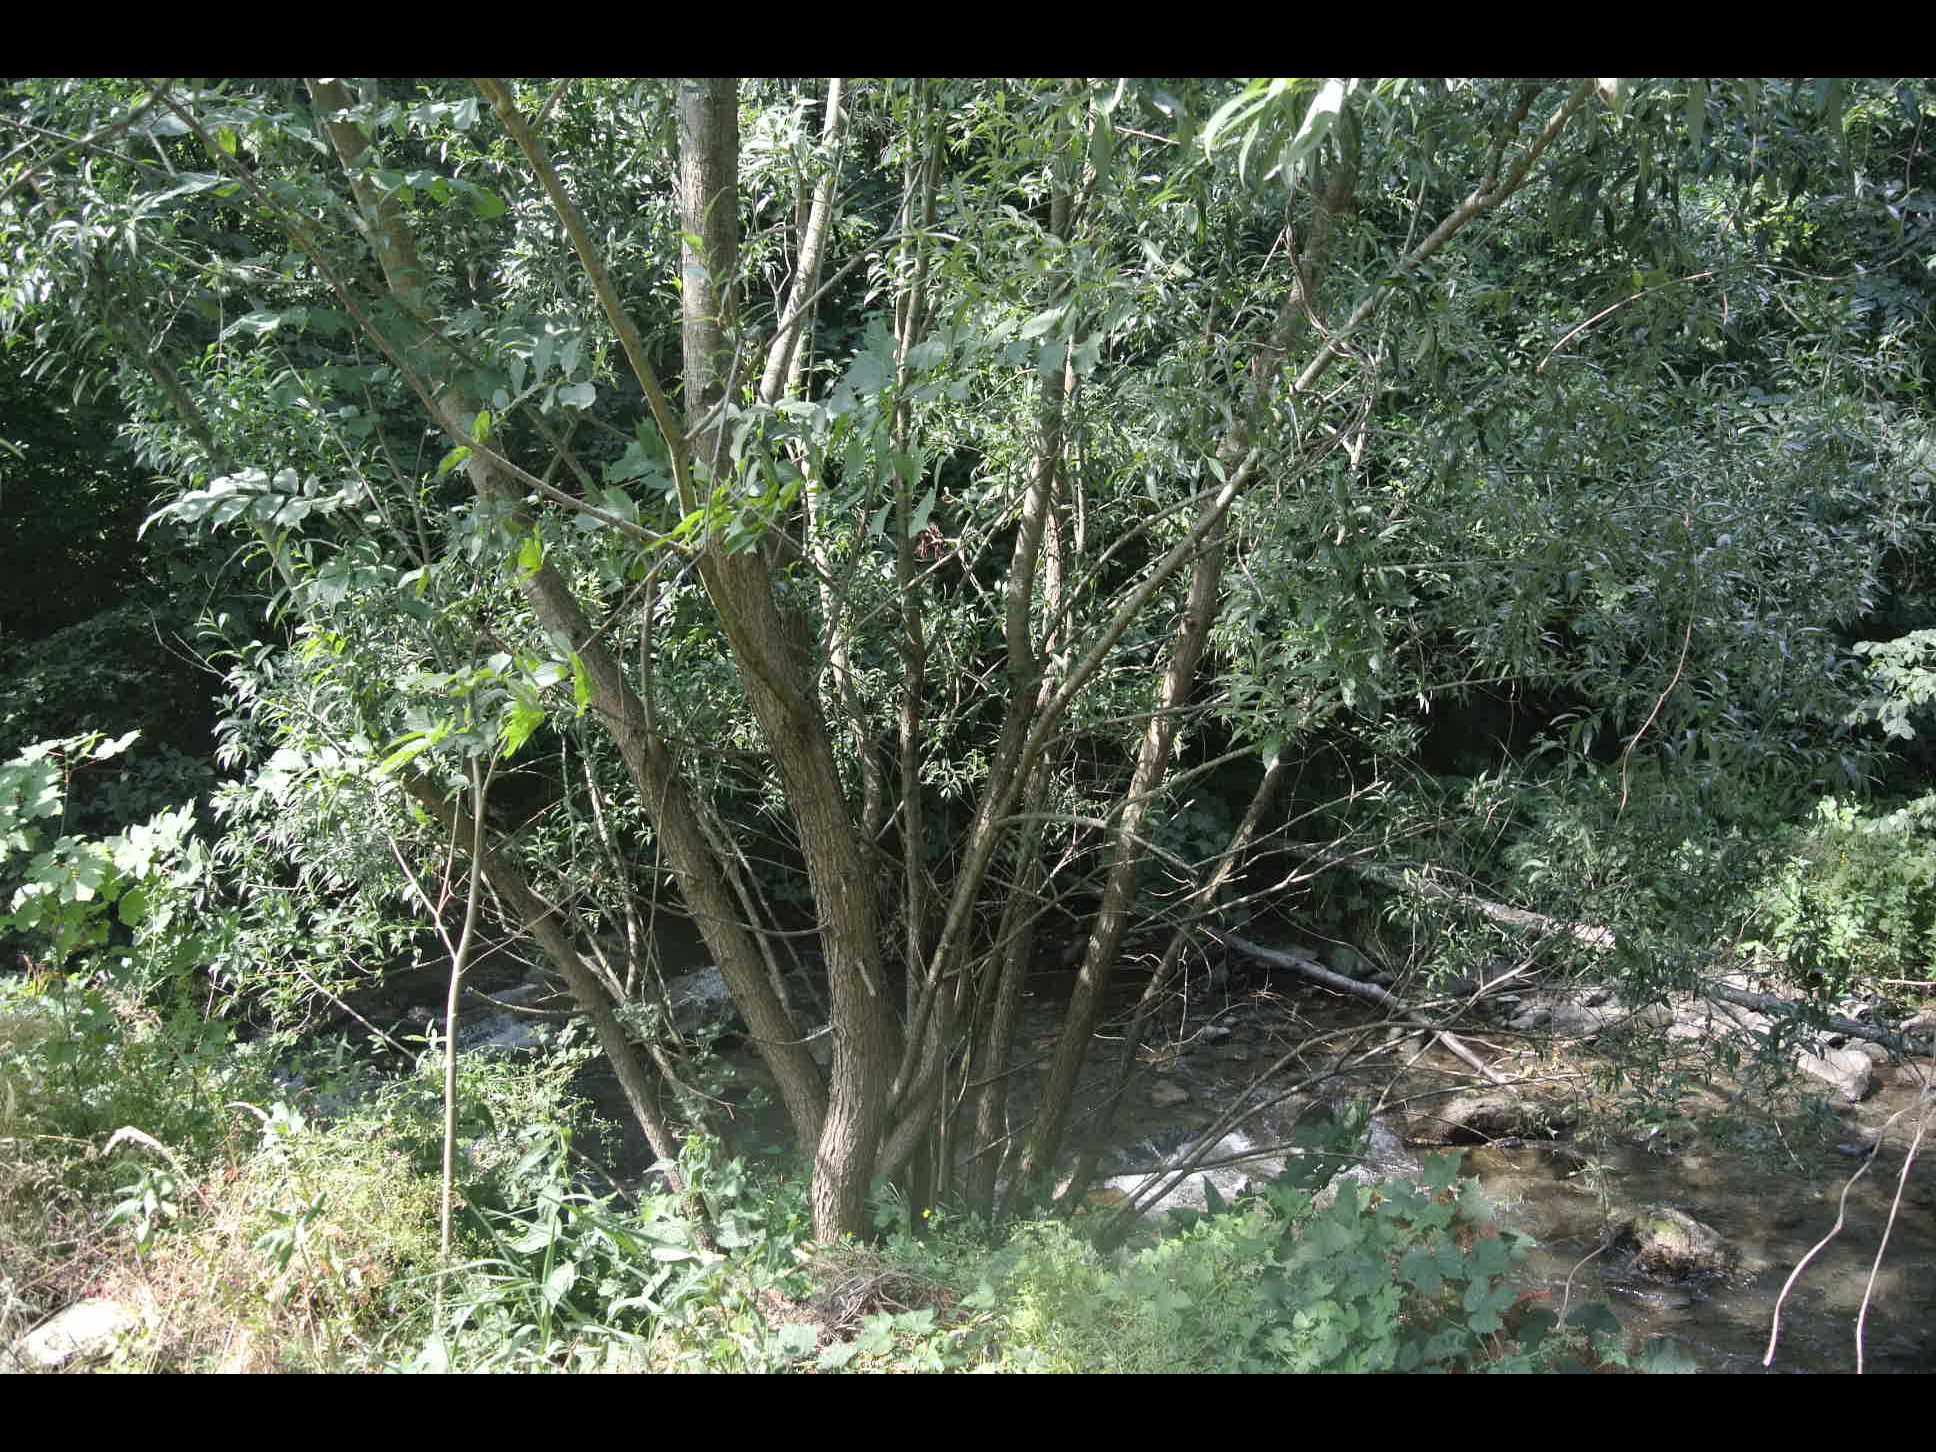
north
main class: Grassland
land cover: Grassland with sparse tree/shrub cover
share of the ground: > 75 %
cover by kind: herbaceous plants 90 %, broadleaved forest trees 5 %, shrubs 5 %
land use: Amenities, museums, leisure
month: July
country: AT
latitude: 47.5522
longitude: 16.0487
